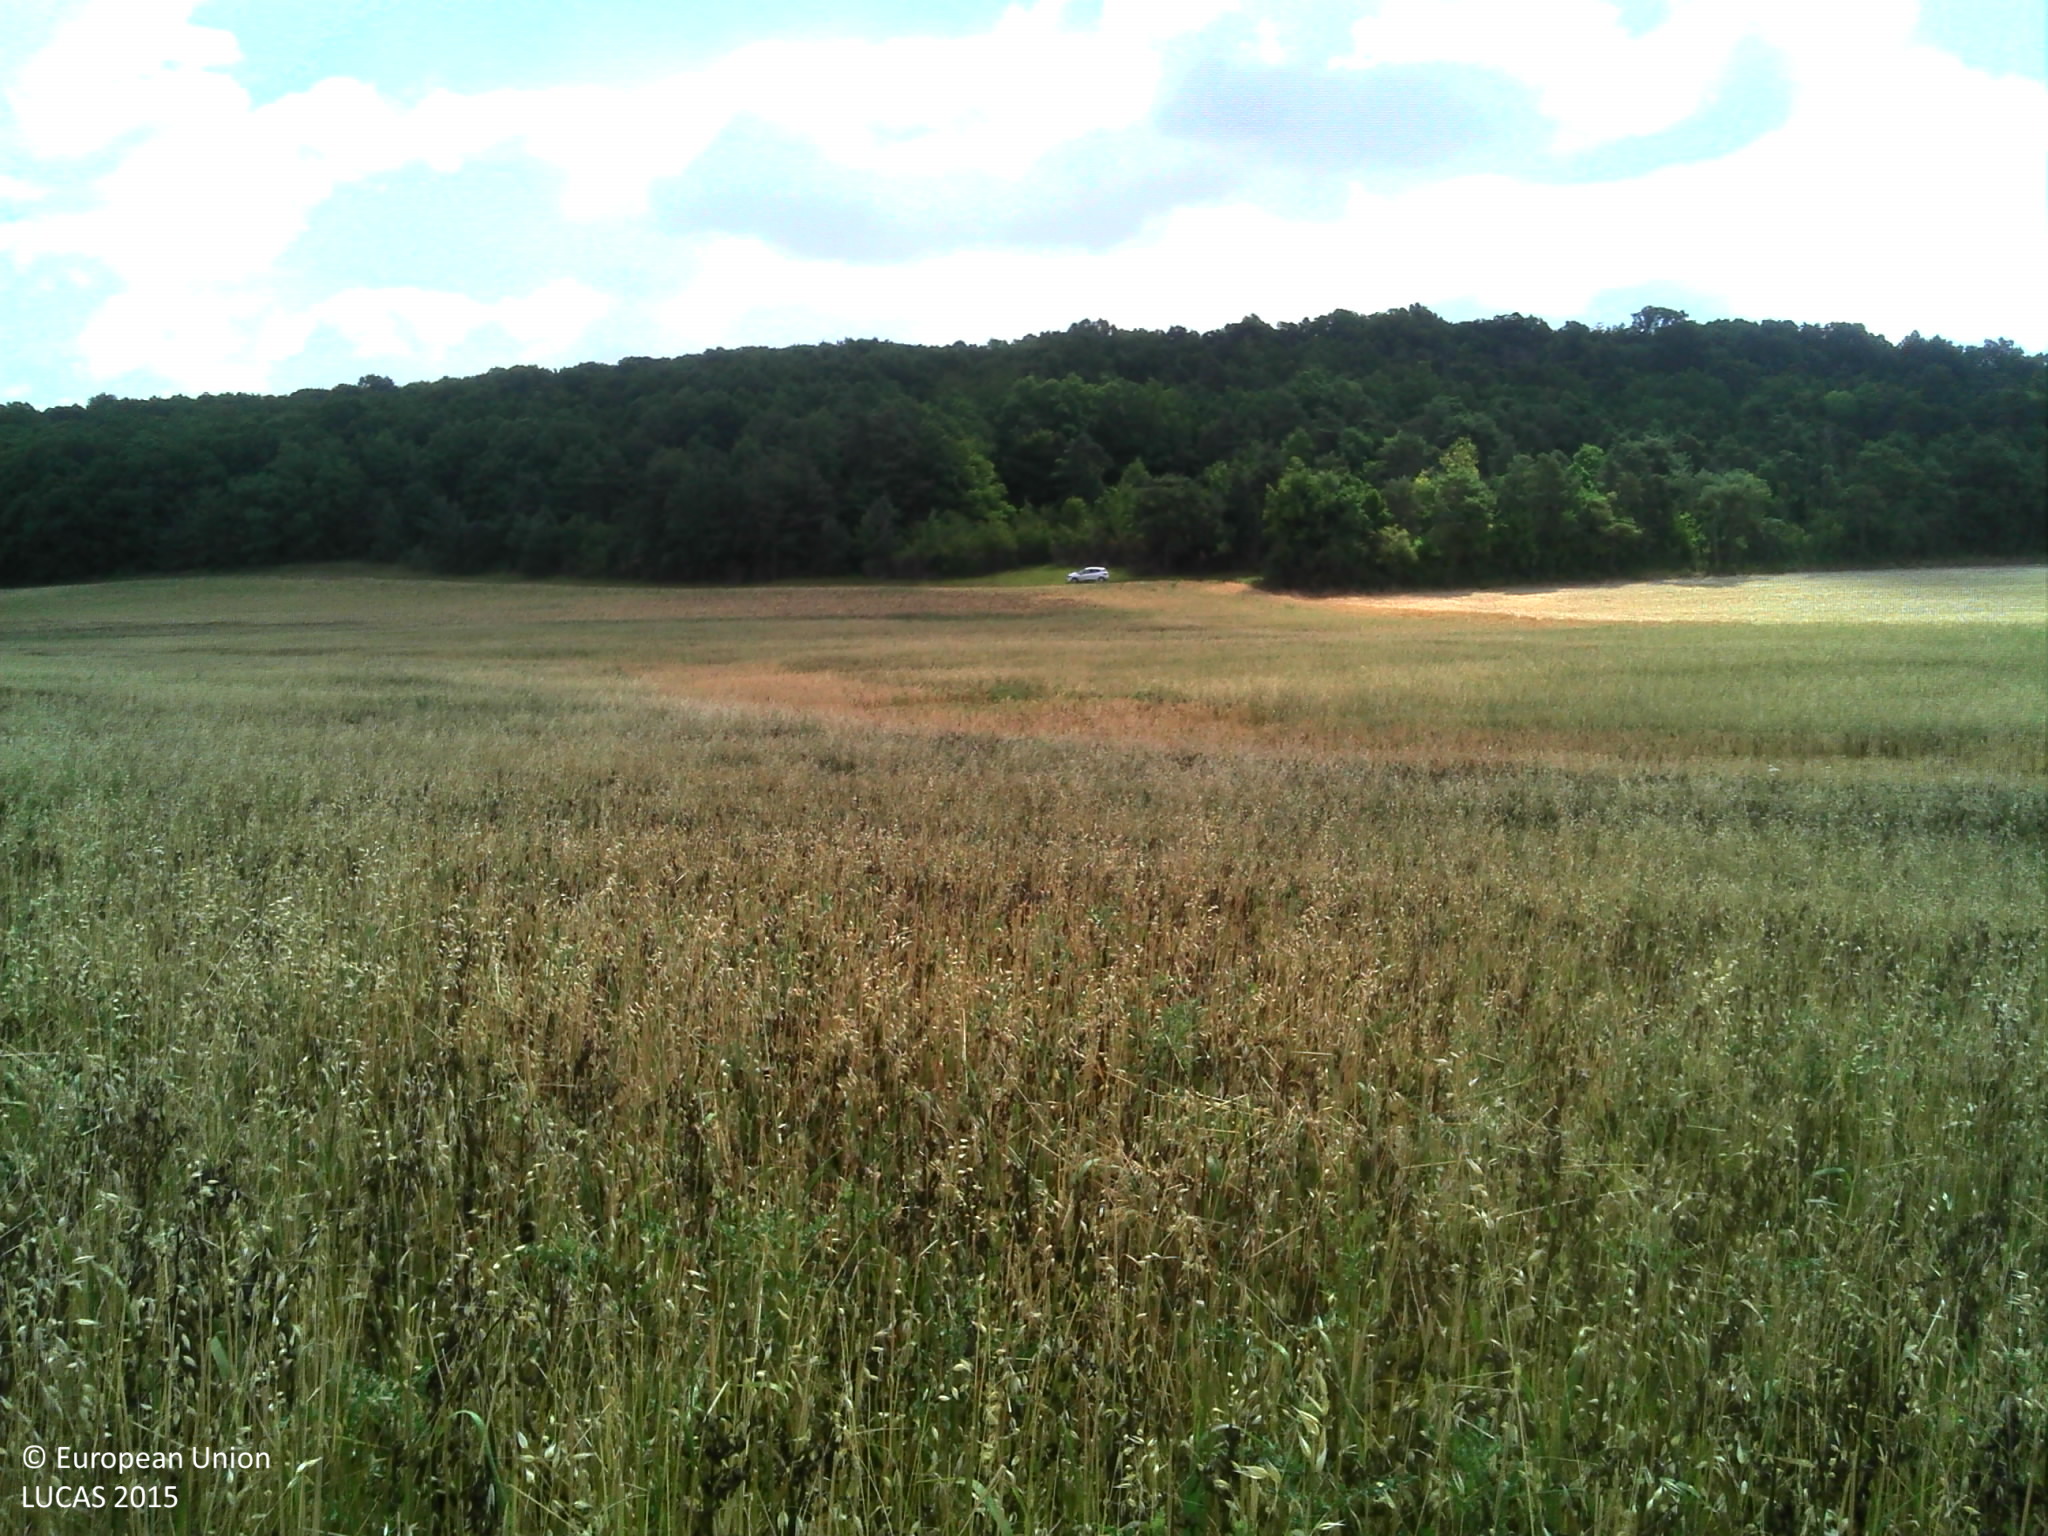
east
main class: Cropland
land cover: Mixed cereals for fodder
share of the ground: > 75 %
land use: Agriculture (excluding fallow land and kitchen gardens)
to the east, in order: Mixed cereals for fodder; Tracks; Broadleaved woodland
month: July
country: FR
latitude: 48.3309
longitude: 3.3707
